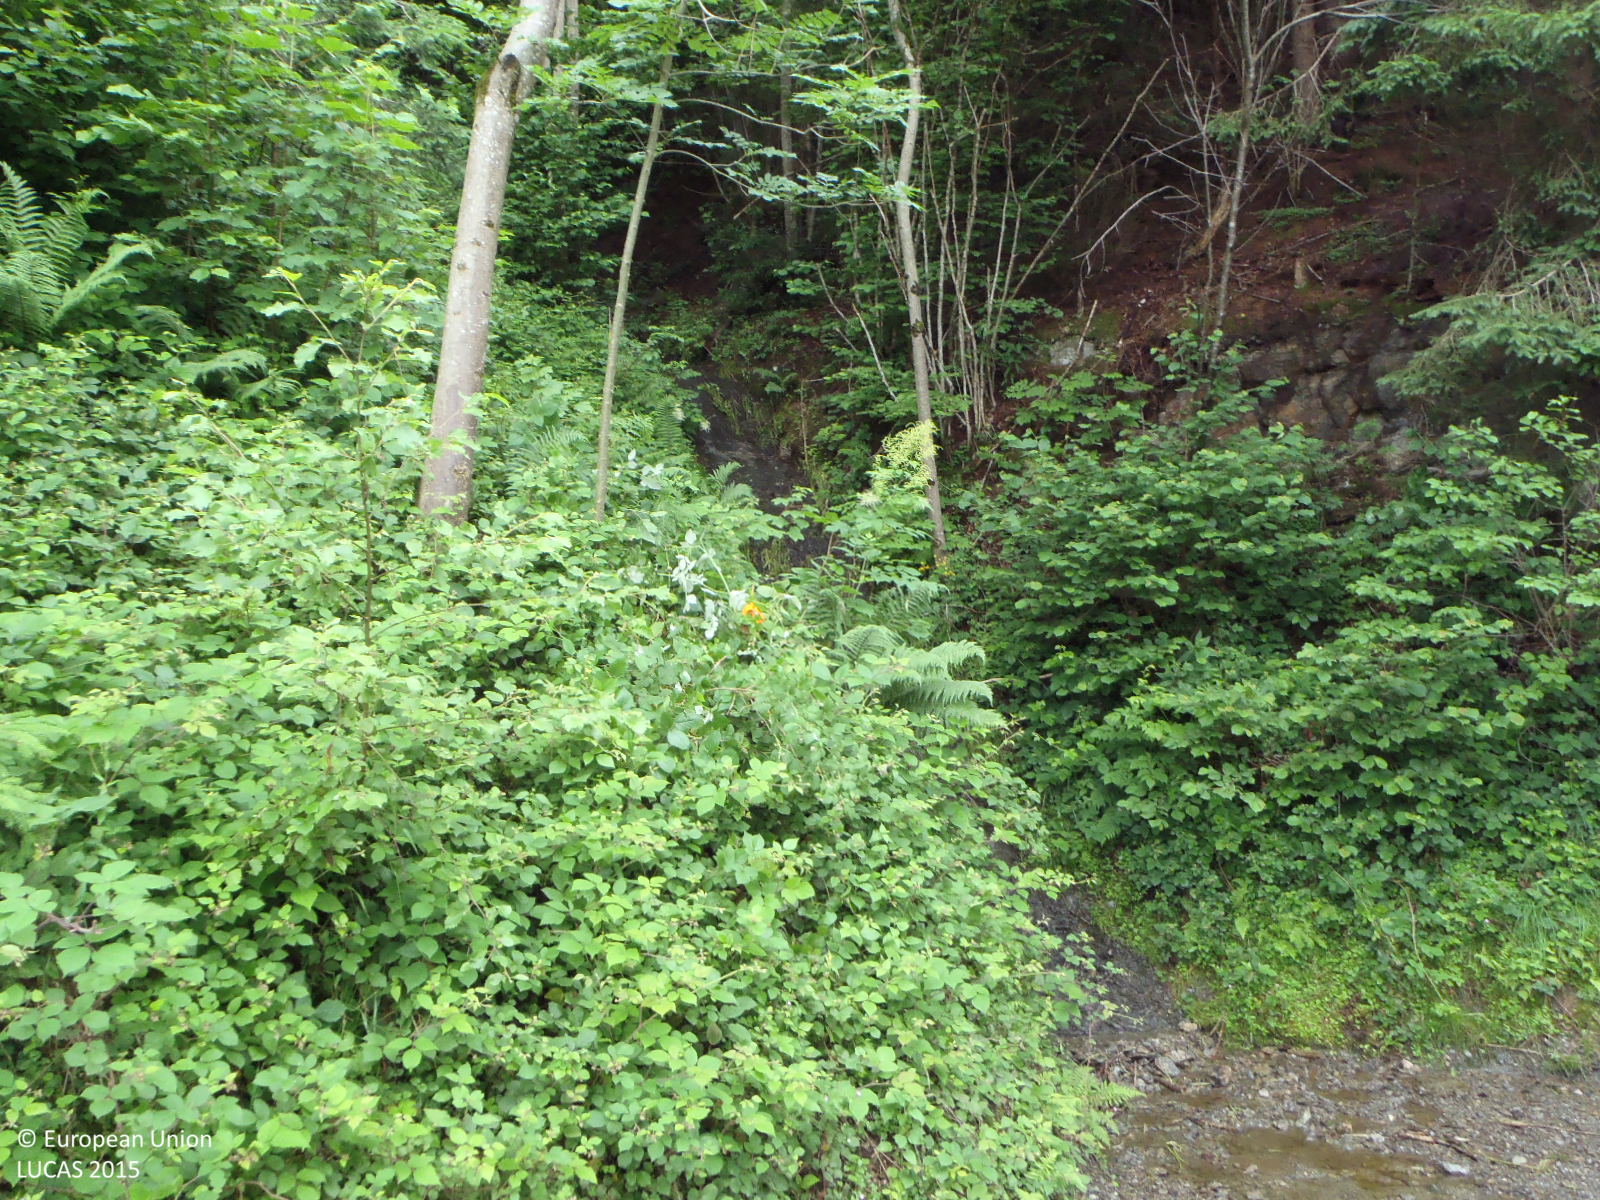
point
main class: Woodland
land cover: Broadleaved woodland
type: mountainous beech forest
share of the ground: 50 - 75 %
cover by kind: broadleaved forest trees 60 %, shrubs 20 %, coniferous forest trees 10 %, herbaceous plants 10 %
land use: Forestry
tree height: > 5 m
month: June
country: AT
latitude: 47.3058
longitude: 12.7889
